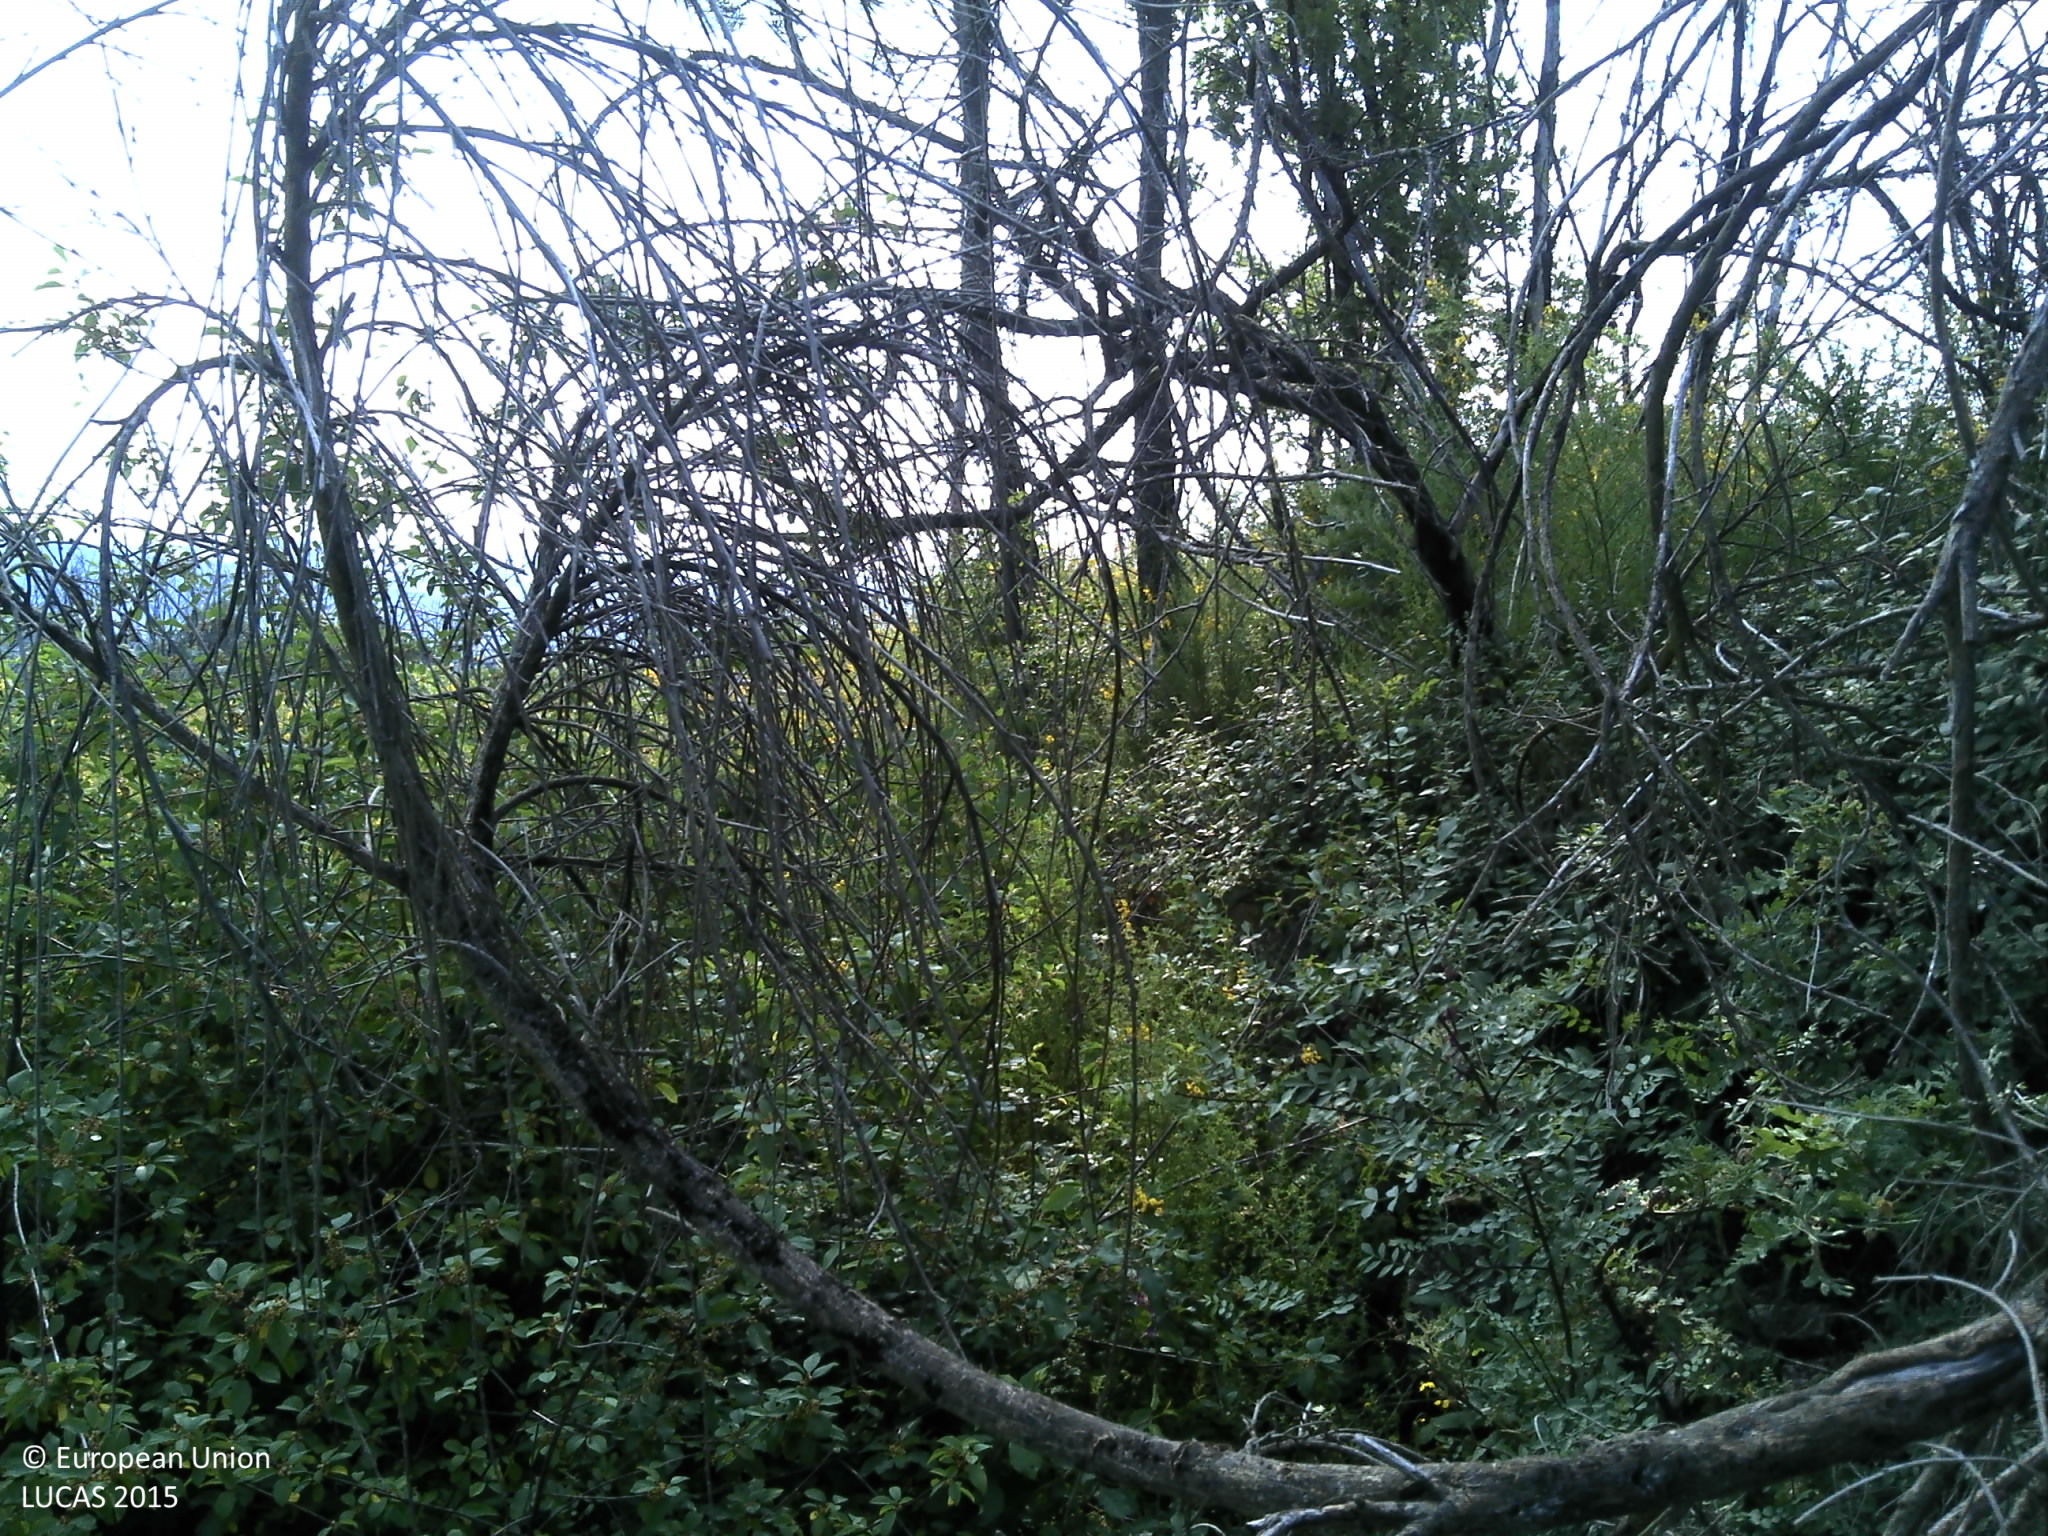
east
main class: Shrubland
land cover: Shrubland with sparse tree cover
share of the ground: > 75 %
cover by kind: shrubs 95 %, broadleaved forest trees 5 %
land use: Semi-natural and natural areas not in use
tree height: < 5 m
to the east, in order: Shrubland with sparse tree cover; Dry stone walls; Shrubland with sparse tree cover; Dry stone walls; Shrubland with sparse tree cover
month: June
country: PT
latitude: 41.3190
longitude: -7.6045
